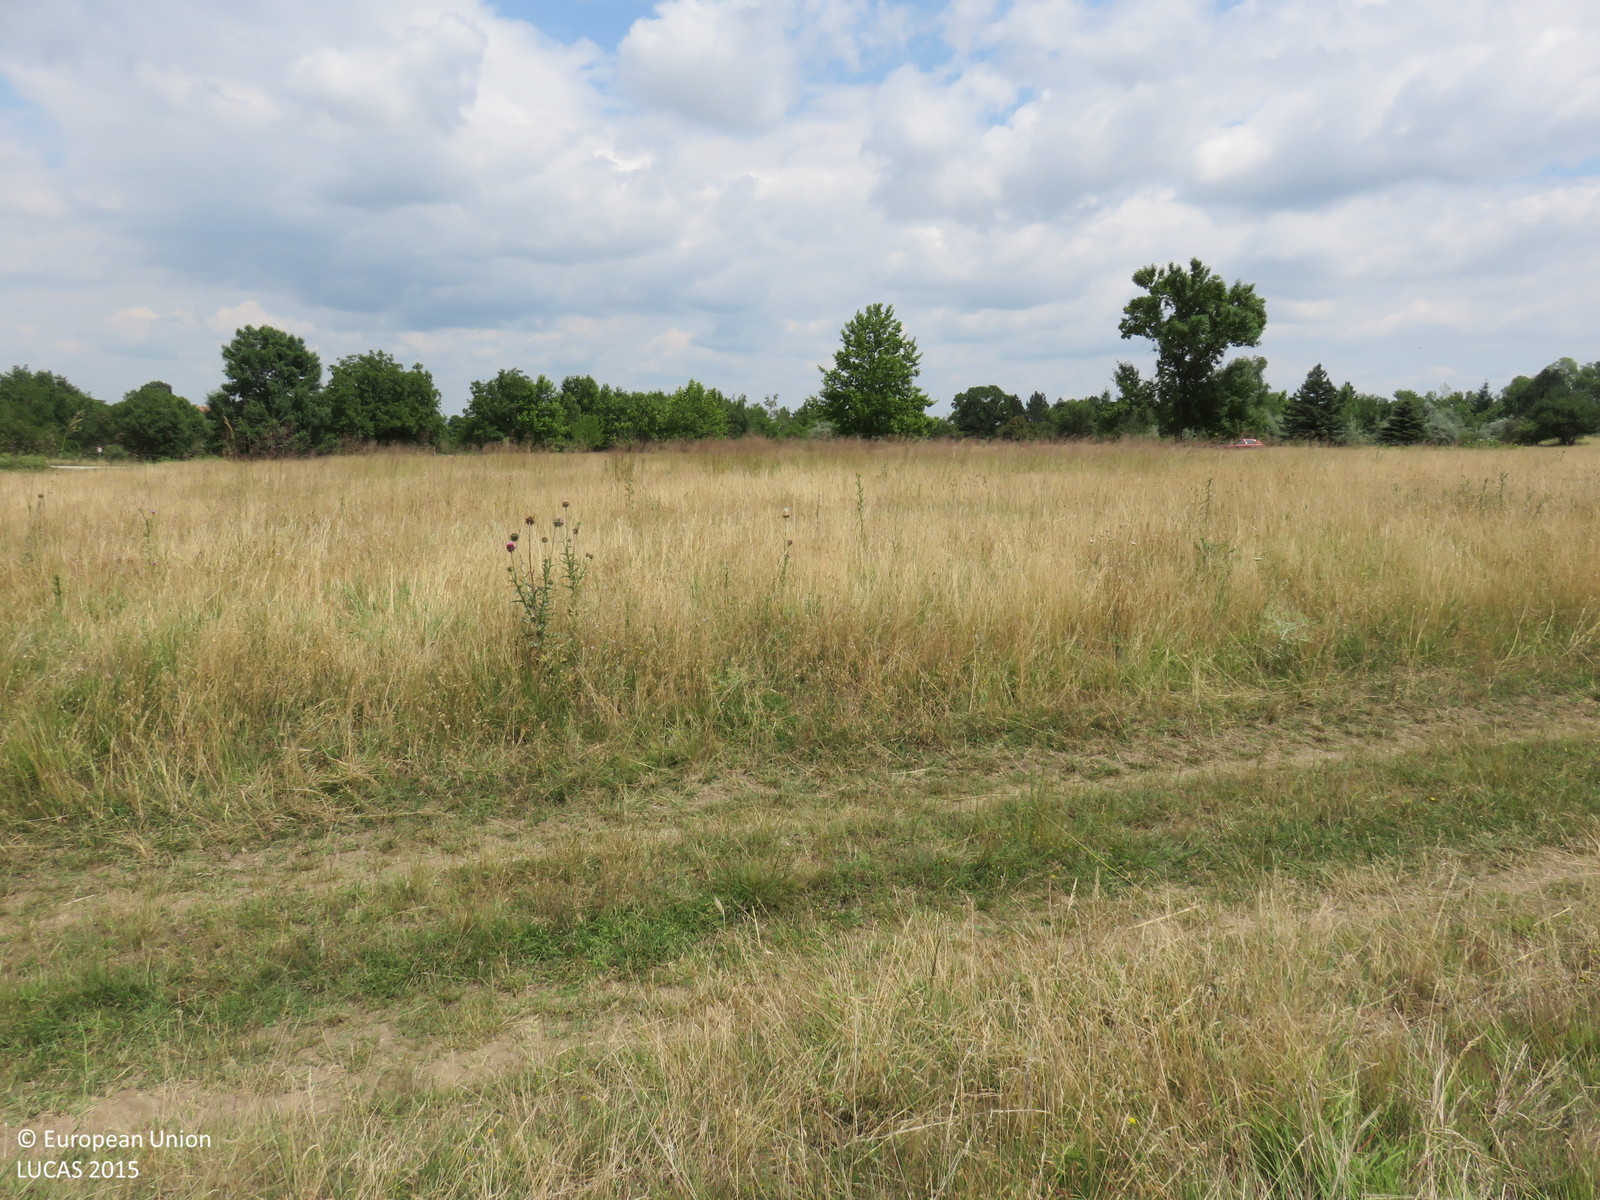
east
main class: Grassland
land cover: Grassland without tree/shrub cover
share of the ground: > 75 %
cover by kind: herbaceous plants 100 %
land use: Agriculture (excluding fallow land and kitchen gardens)
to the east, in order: Grassland without tree/shrub cover; Tracks; Grassland without tree/shrub cover; Paved roads, cycling and walking lanes; Lines of trees; Grassland without tree/shrub cover; Grassland with sparse tree/shrub cover
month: June
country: BG
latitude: 43.4318
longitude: 24.9053
